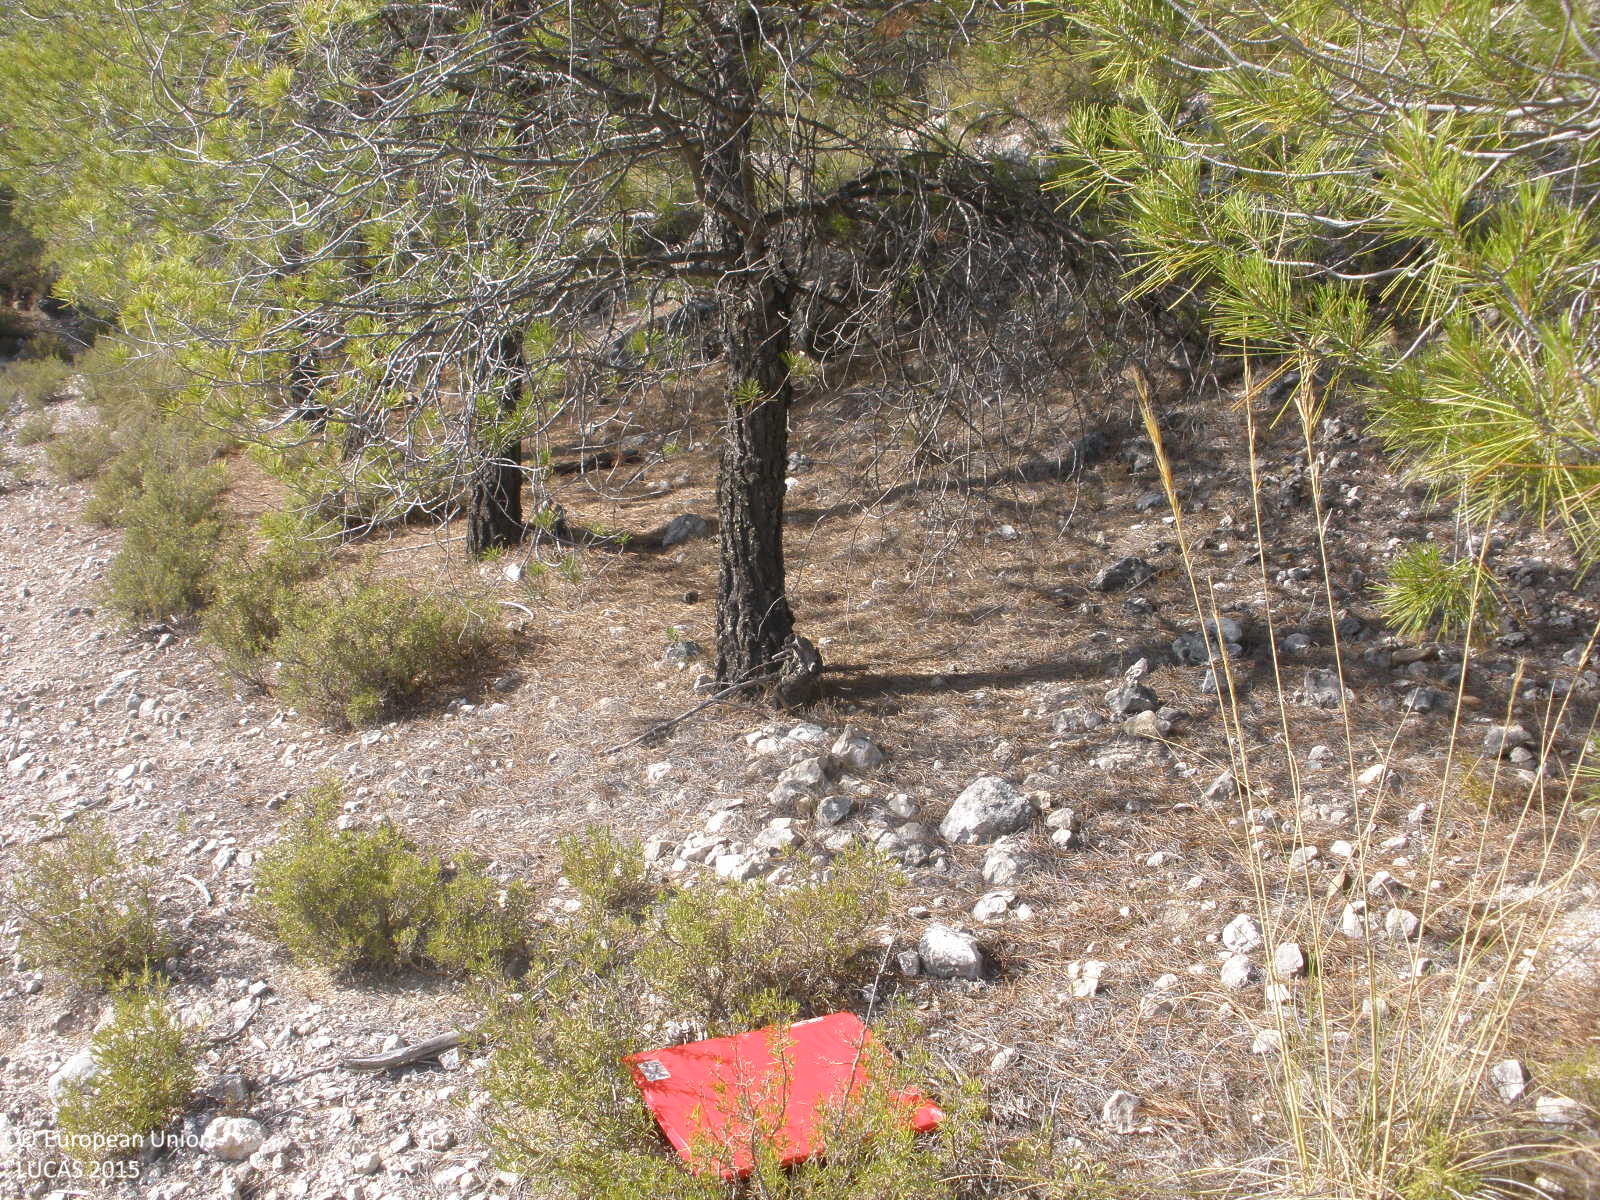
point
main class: Woodland
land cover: Pine dominated coniferous woodland
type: coniferous forest of the mediterranean region
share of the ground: 50 - 75 %
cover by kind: coniferous forest trees 60 %, shrubs 30 %, consolidated bare surface 10 %
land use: Forestry
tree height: < 5 m
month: July
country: ES
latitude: 40.3124
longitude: -3.4116
